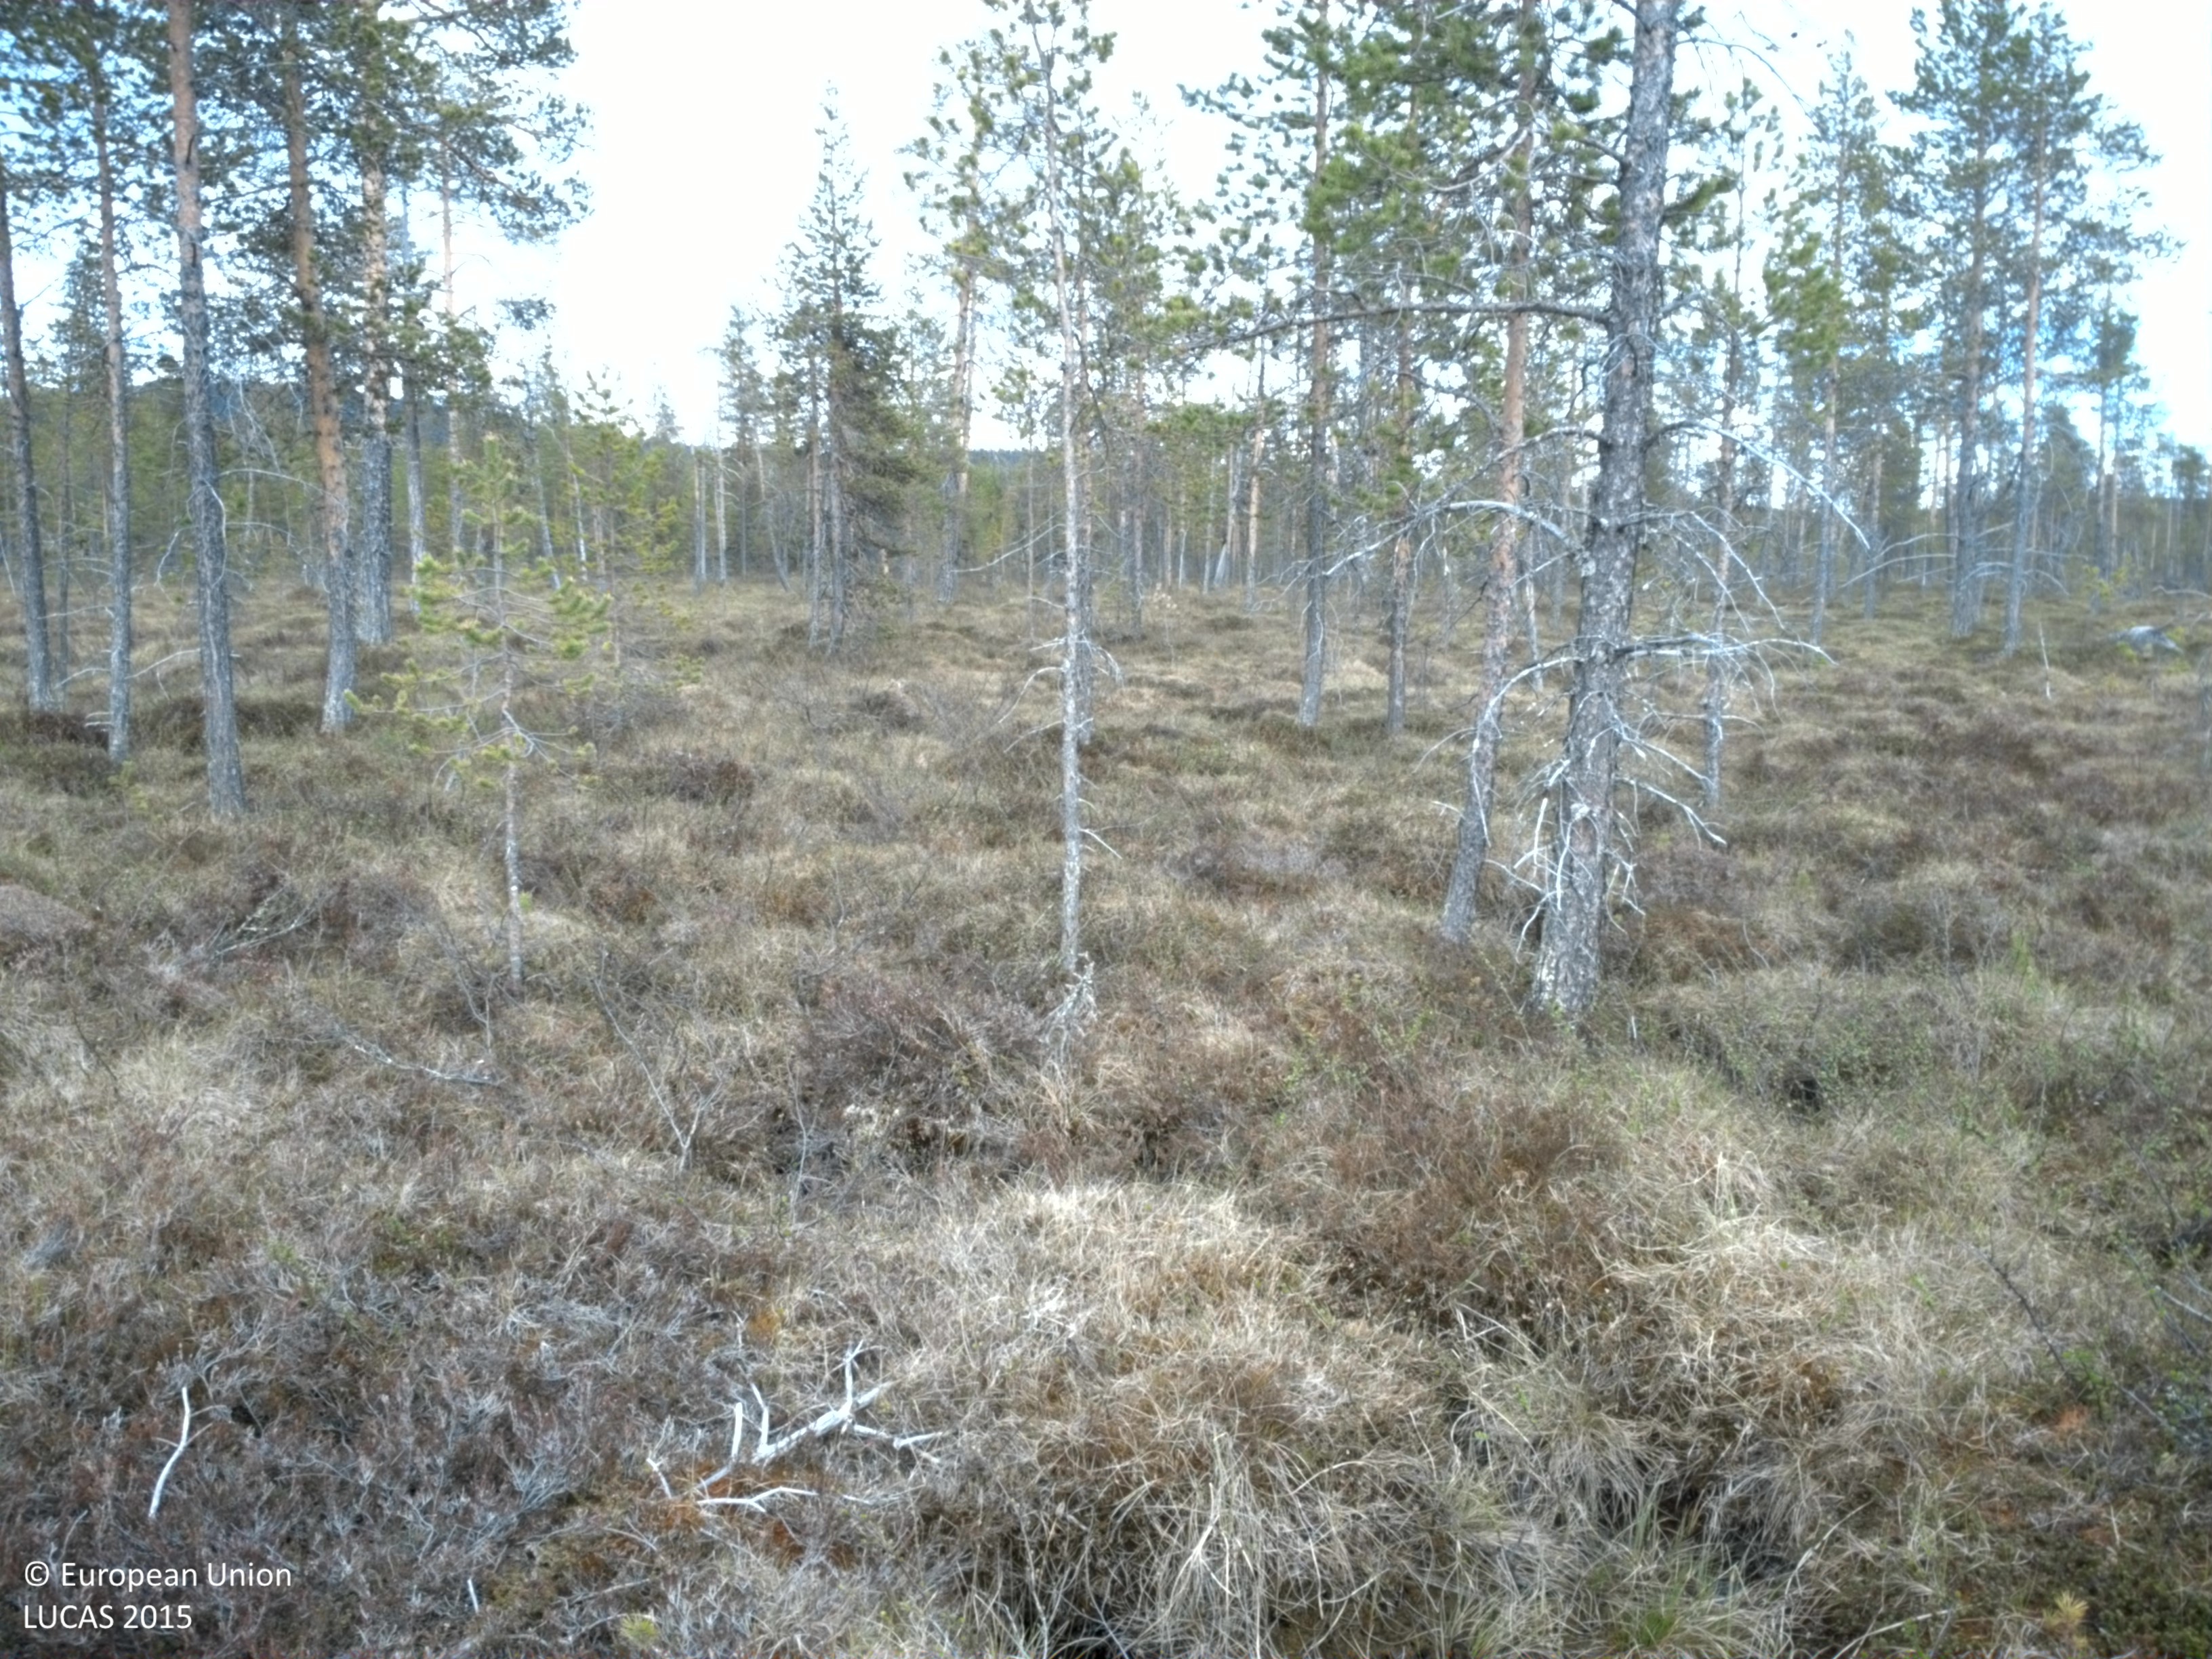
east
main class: Shrubland
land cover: Shrubland without tree cover
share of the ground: 25 - 50 %
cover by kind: herbaceous plants 60 %, shrubs 40 %
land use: Semi-natural and natural areas not in use
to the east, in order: Shrubland without tree cover; Pine dominated coniferous woodland; Shrubland with sparse tree cover; Pine dominated coniferous woodland
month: June
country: SE
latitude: 66.2526
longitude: 18.6992
